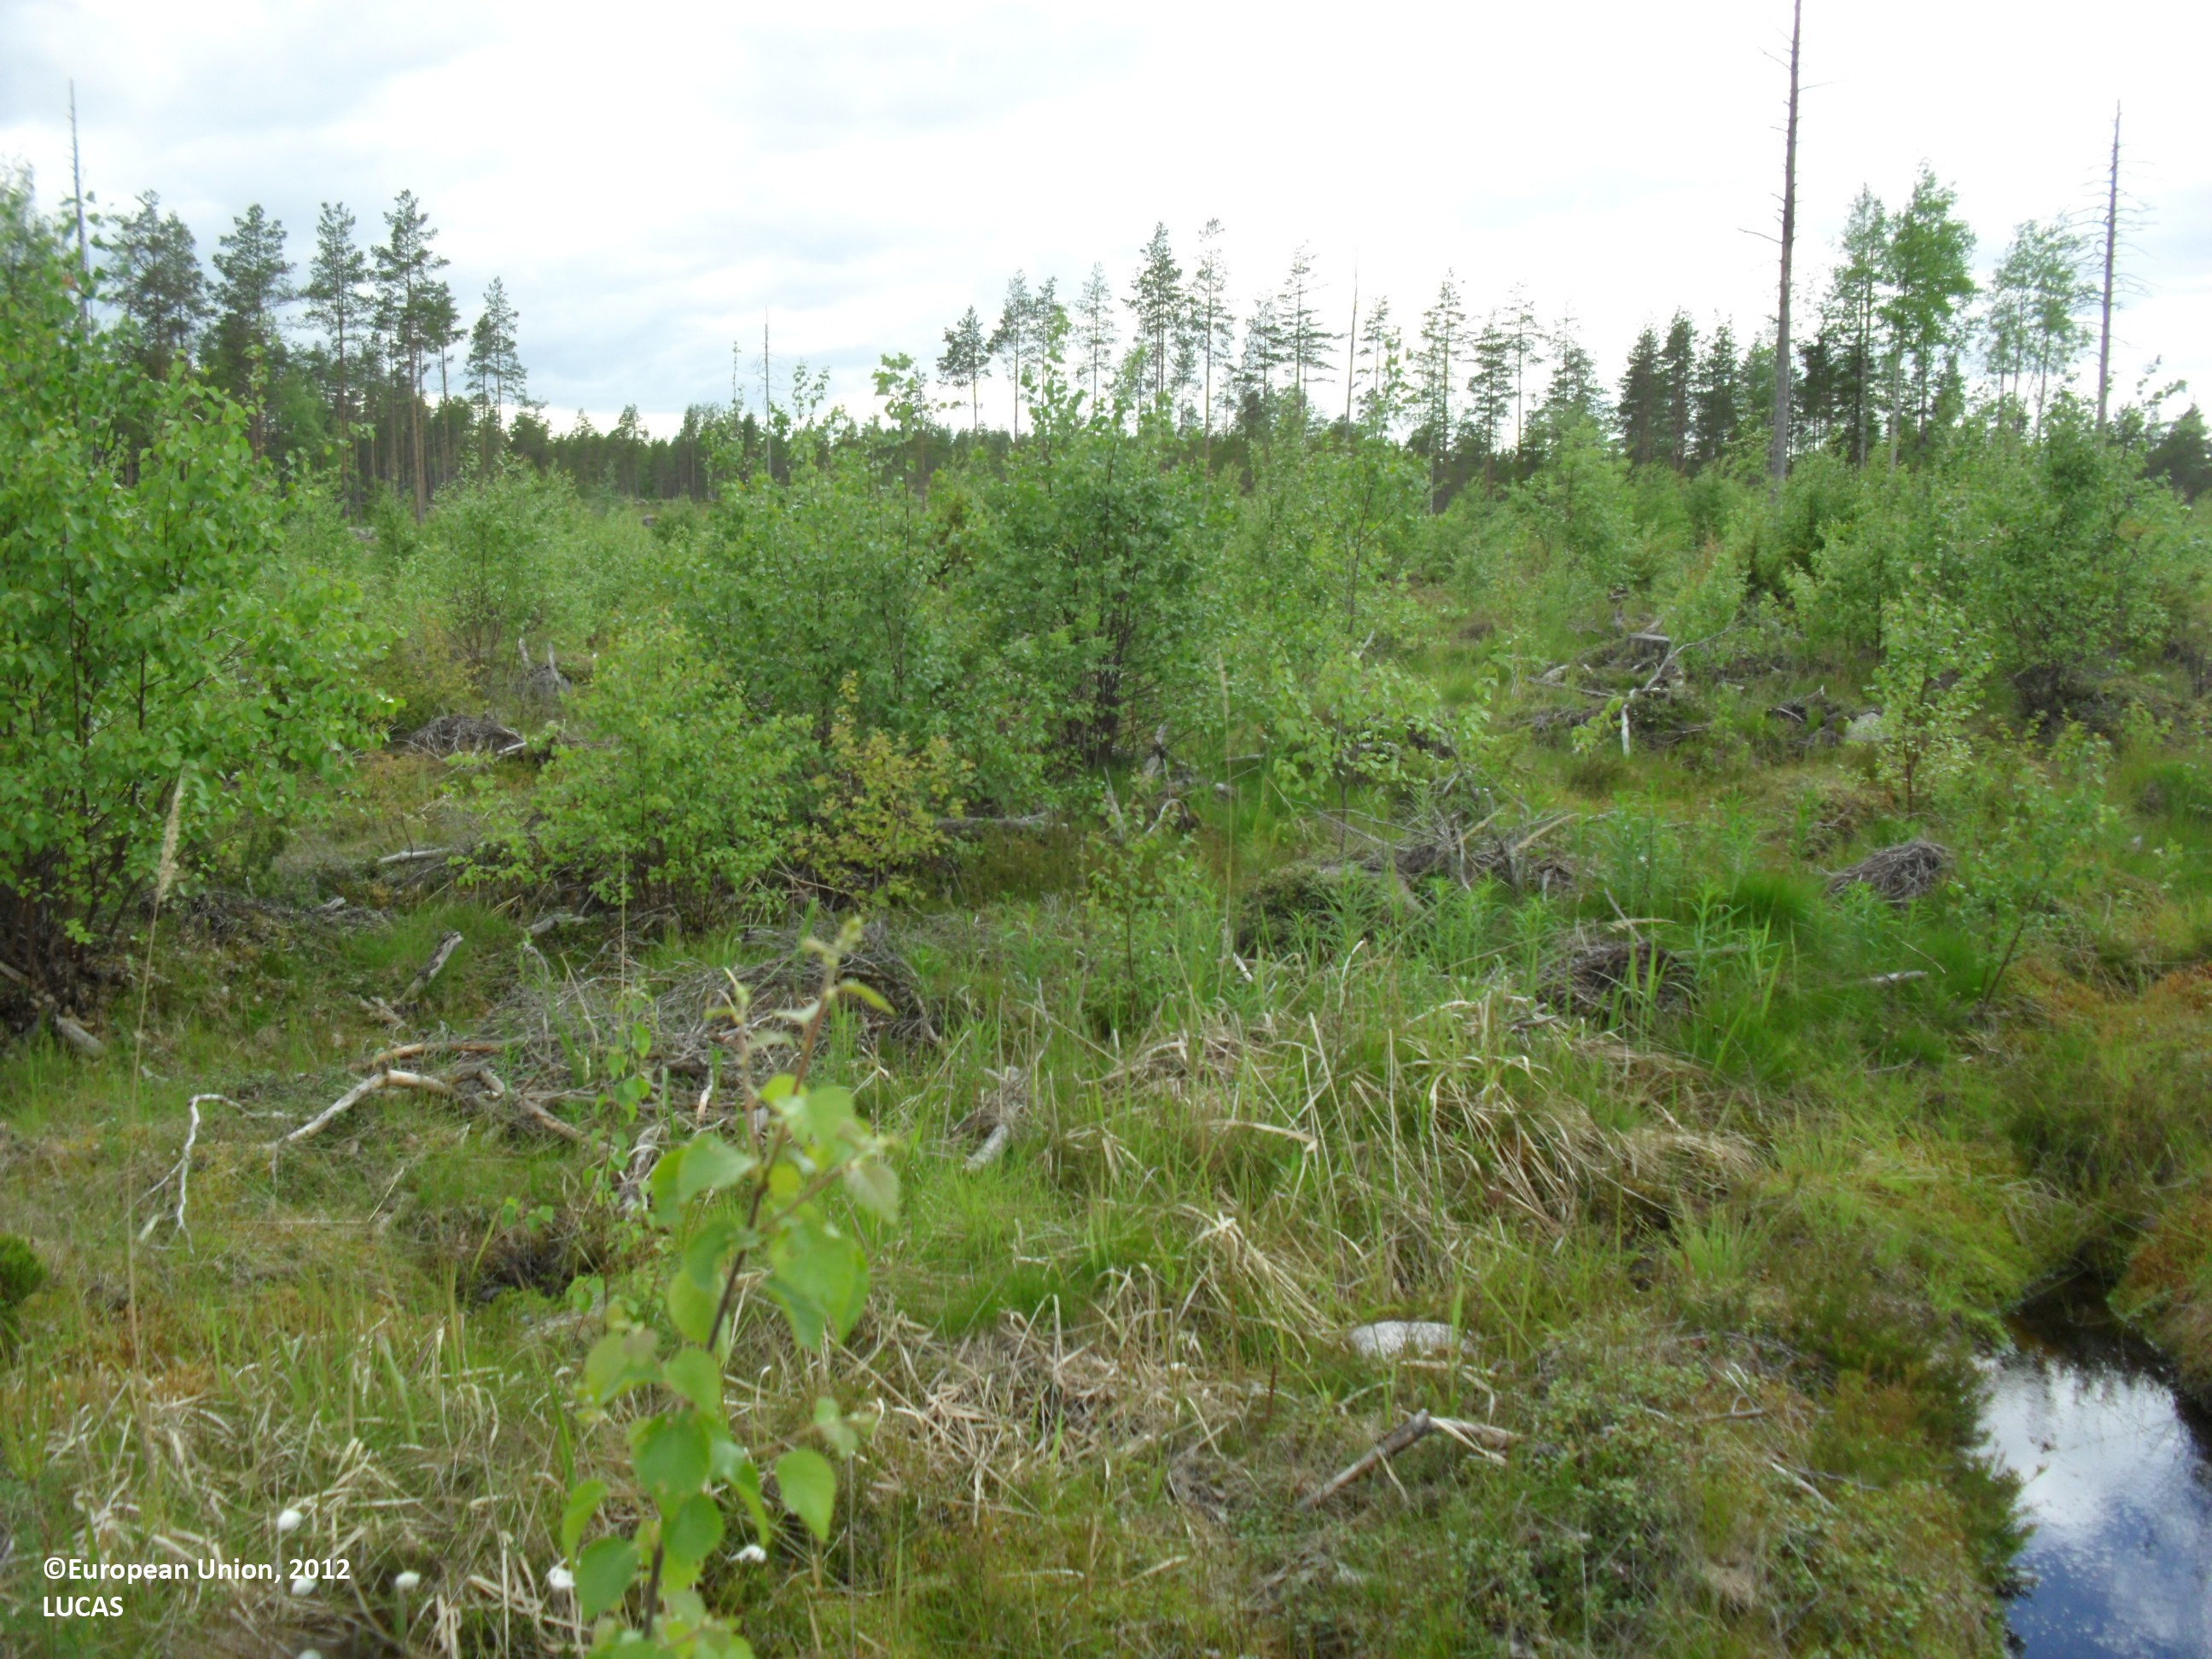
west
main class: Grassland
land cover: Grassland with sparse tree/shrub cover
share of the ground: > 75 %
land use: Forestry
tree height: < 5 m
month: June
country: FI
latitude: 63.2005
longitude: 22.9988
